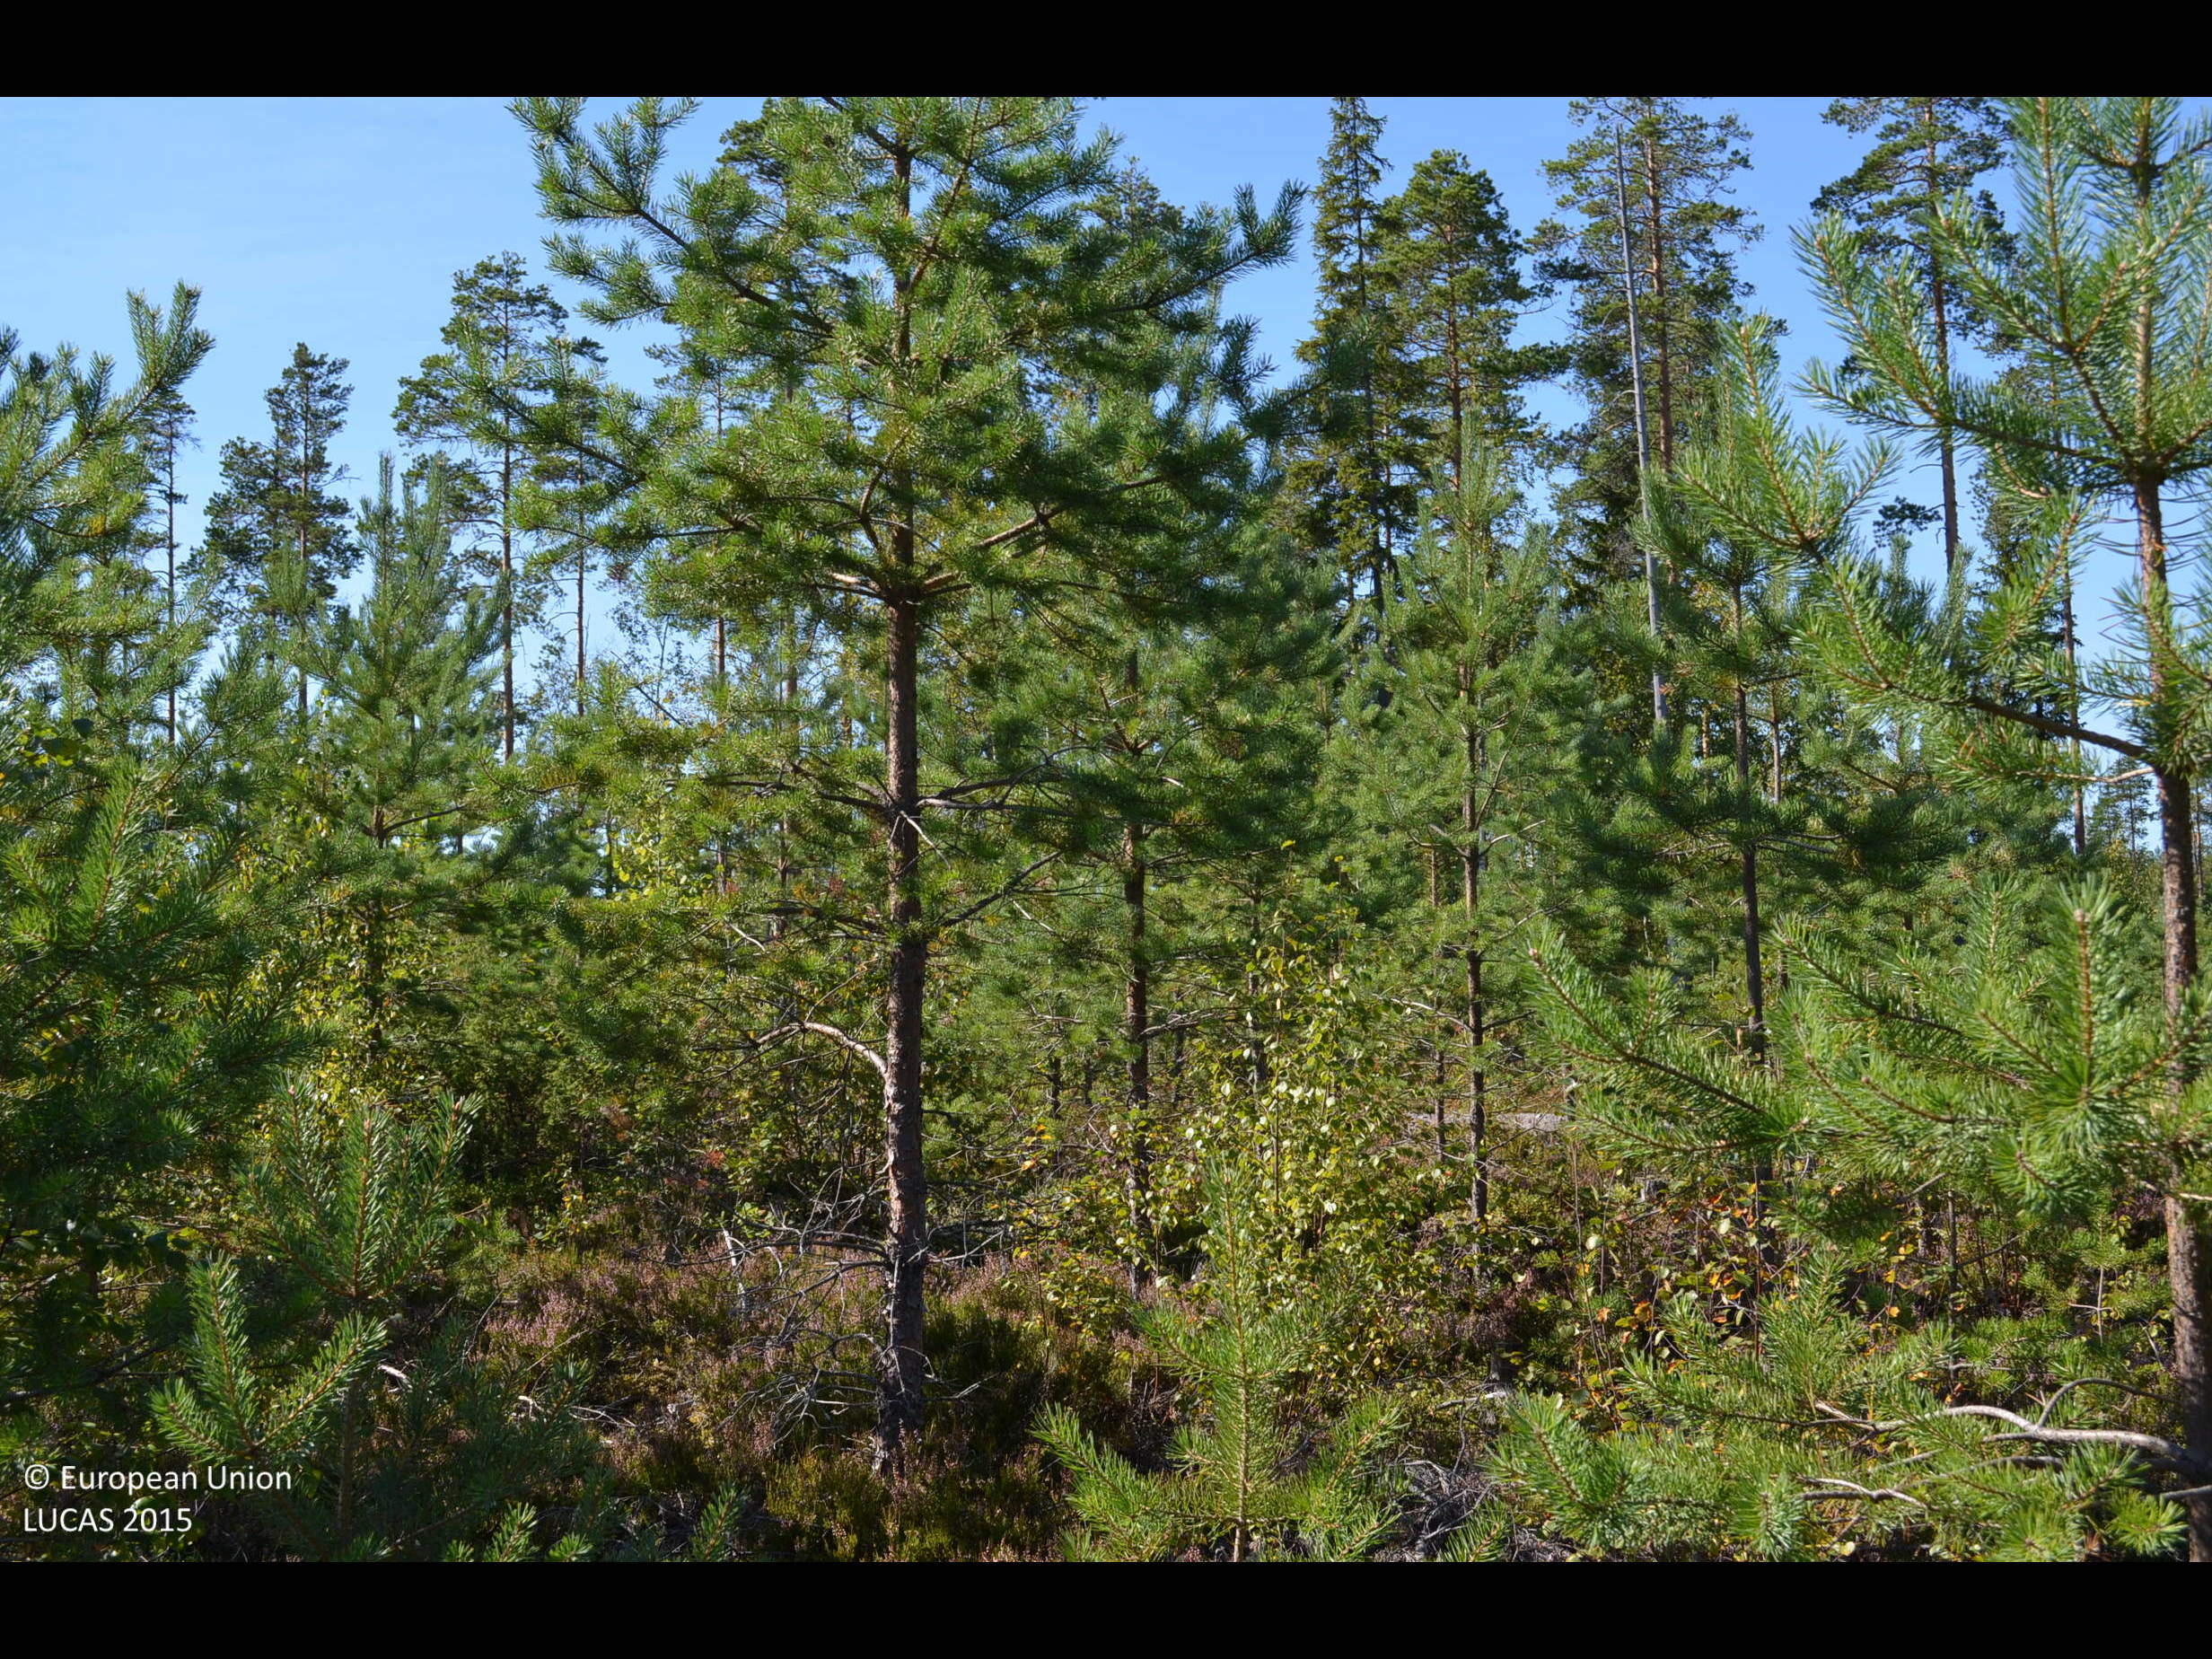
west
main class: Woodland
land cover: Pine dominated mixed woodland
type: boreal forest
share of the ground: > 75 %
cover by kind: coniferous forest trees 55 %, shrubs 25 %, broadleaved forest trees 20 %
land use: Amenities, museums, leisure
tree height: < 5 m
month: August
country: FI
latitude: 62.5965
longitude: 23.8058
